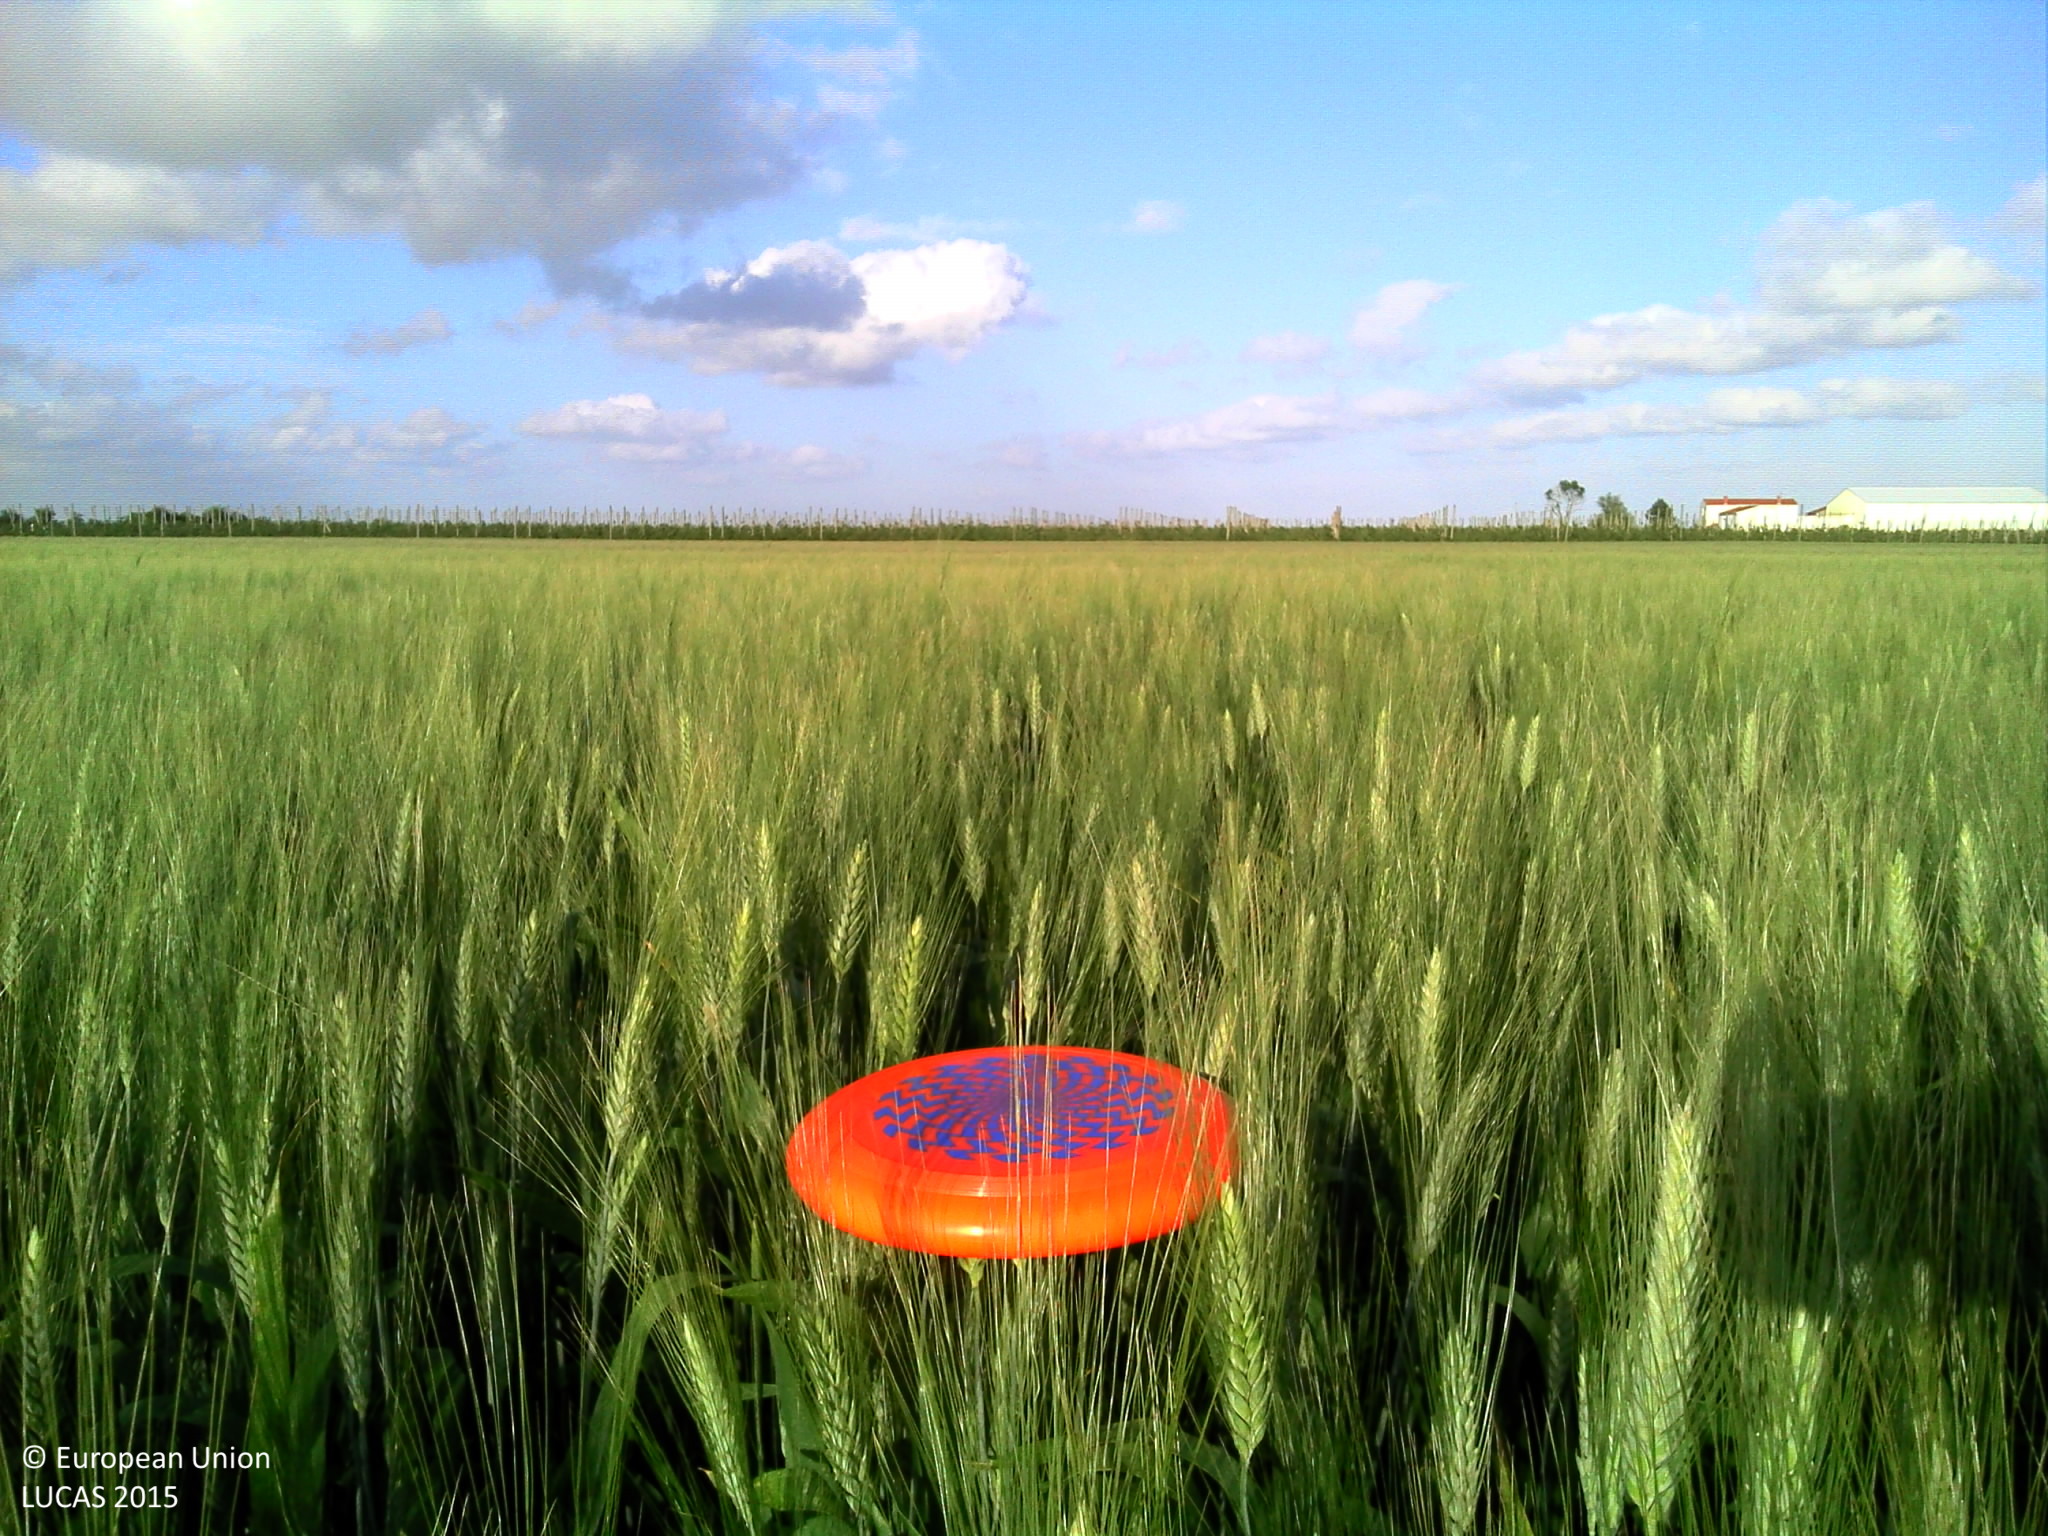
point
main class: Cropland
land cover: Common wheat
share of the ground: > 75 %
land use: Agriculture (excluding fallow land and kitchen gardens)
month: June
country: FR
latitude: 46.3033
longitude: -1.0545
